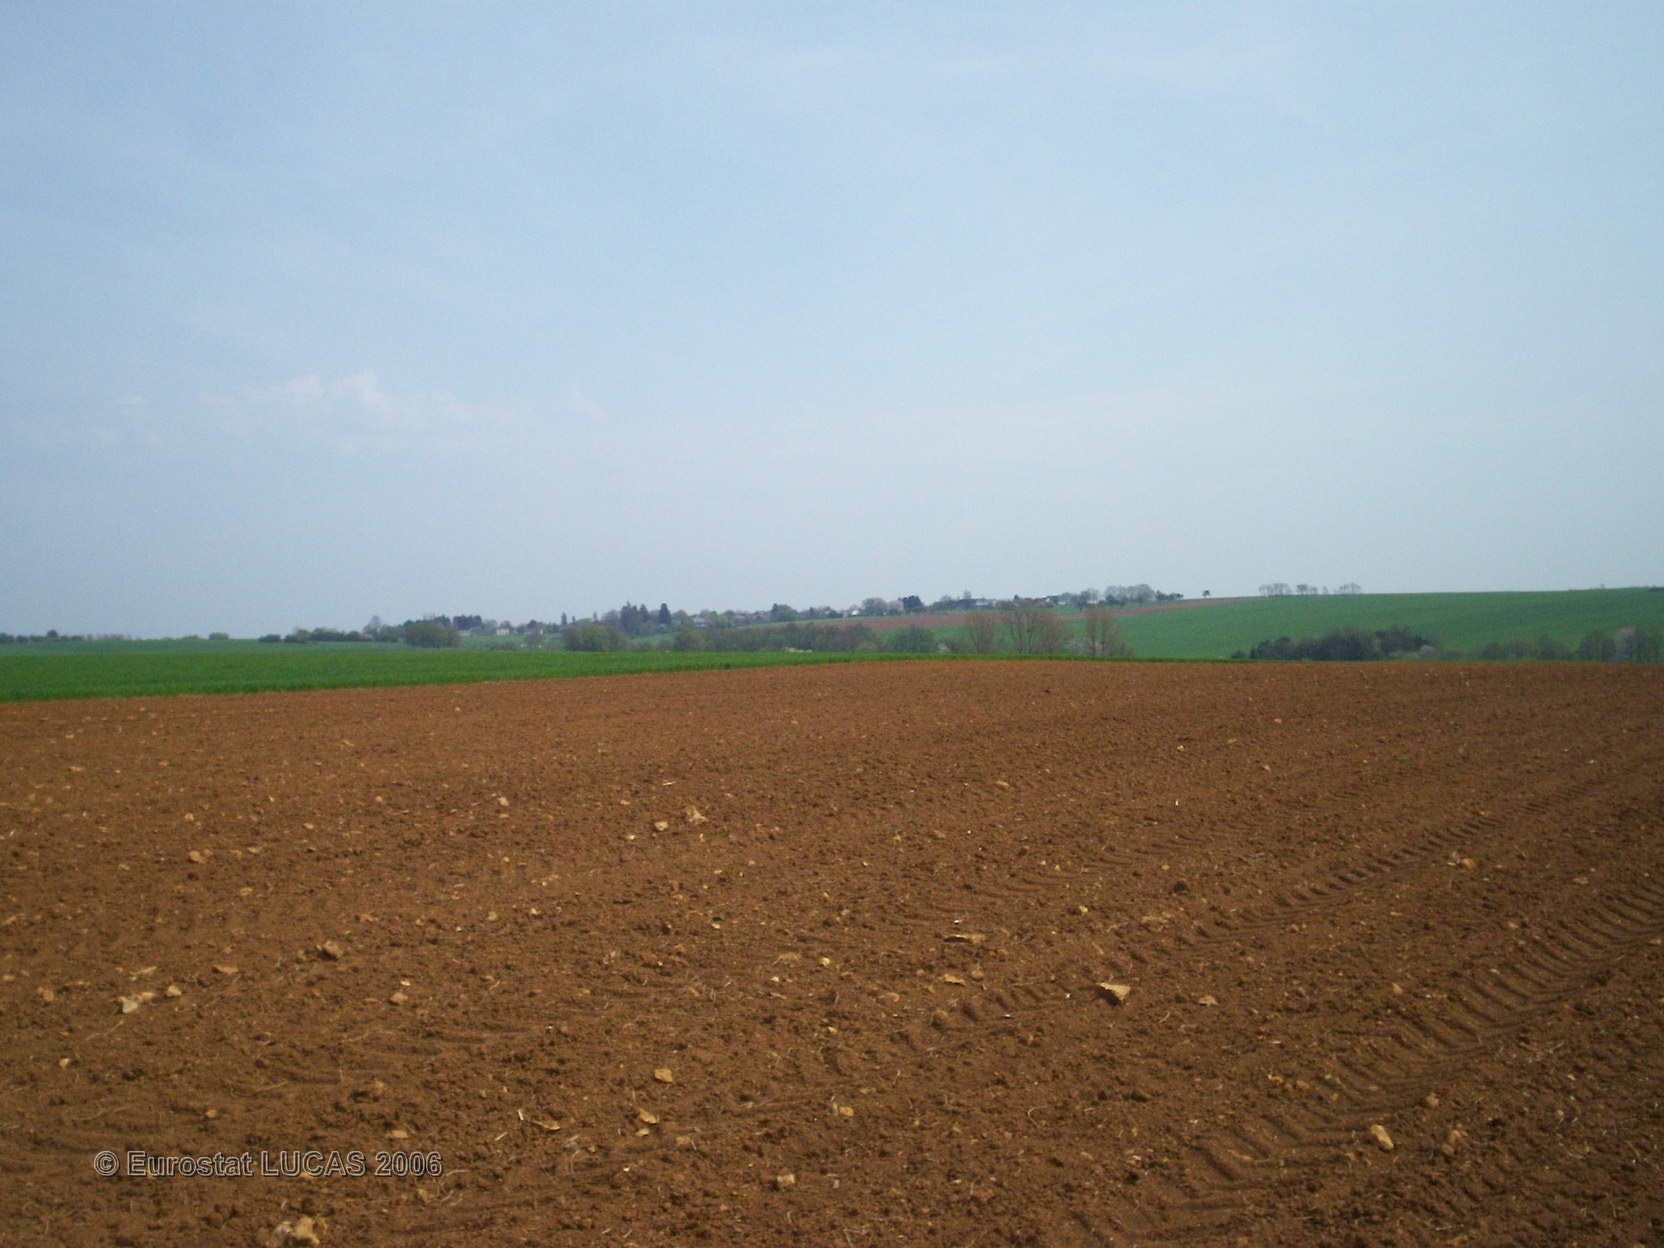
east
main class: Cropland
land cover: Maize
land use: Agriculture (excluding fallow land and kitchen gardens)
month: May
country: FR
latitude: 49.8631
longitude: 4.3336
